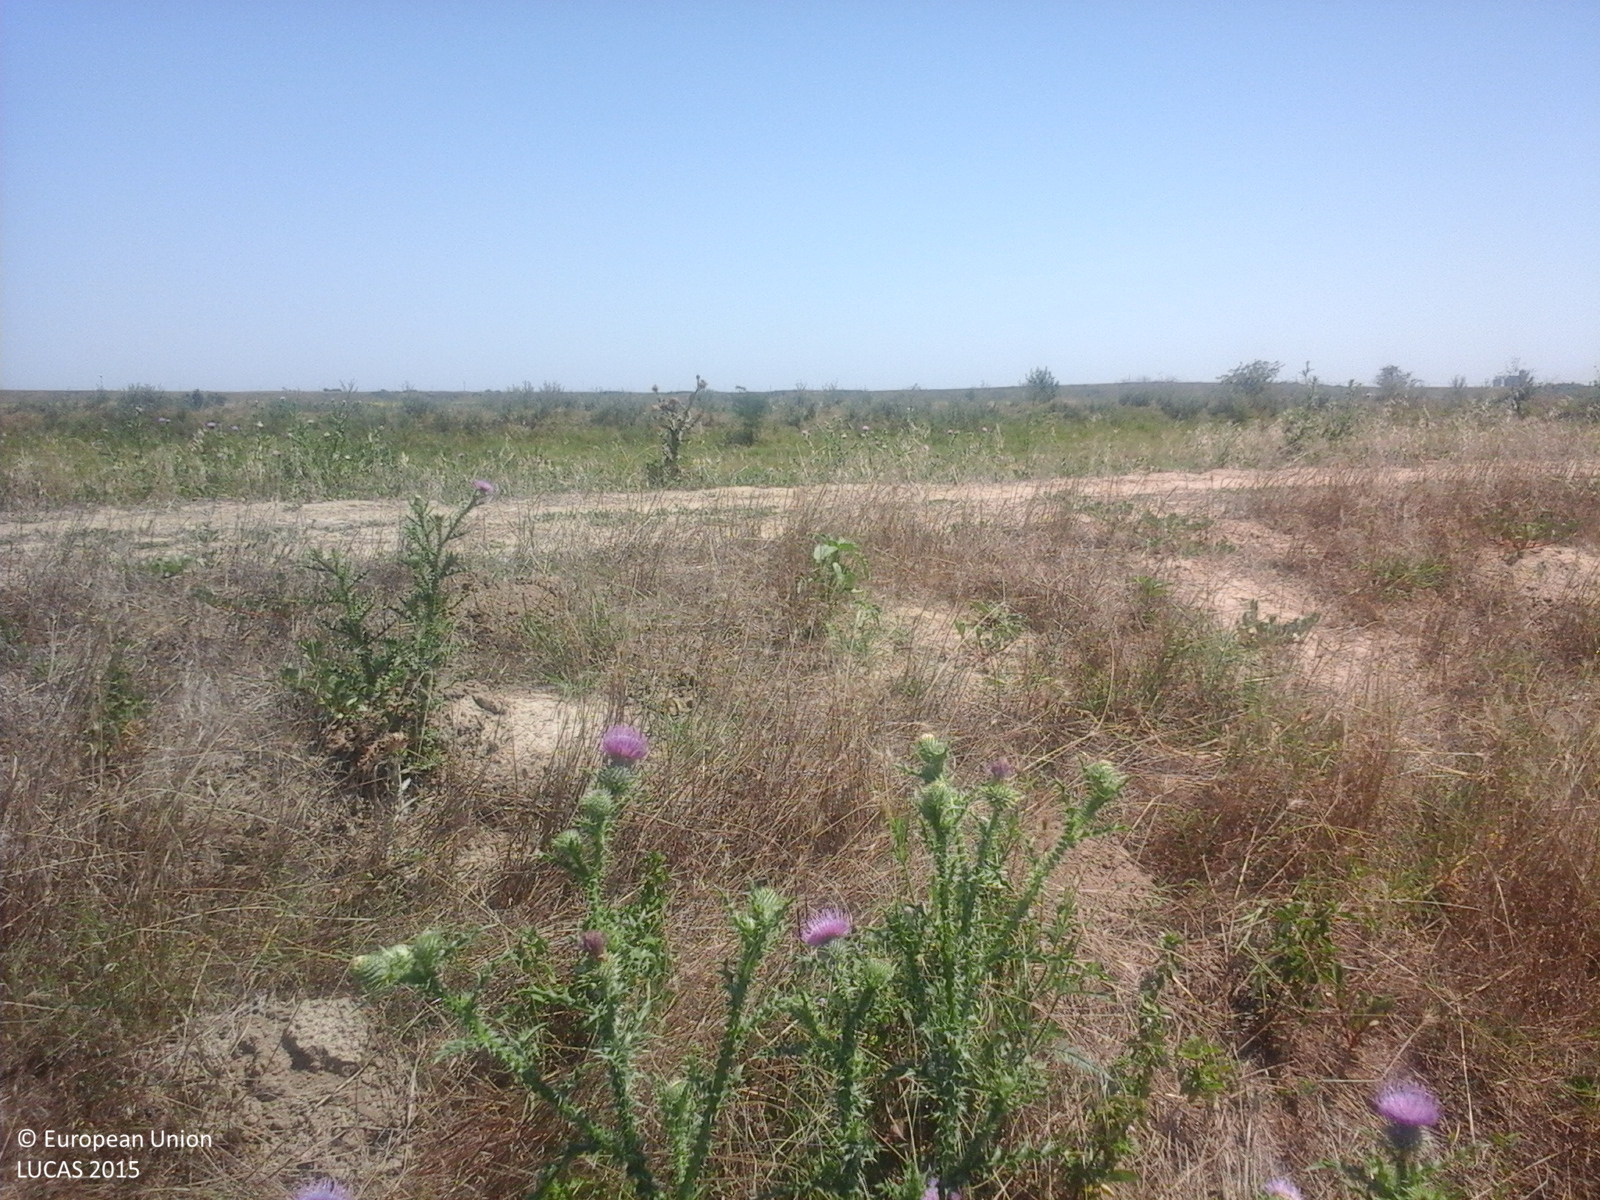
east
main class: Grassland
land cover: Grassland with sparse tree/shrub cover
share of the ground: > 75 %
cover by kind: herbaceous plants 85 %, shrubs 10 %, broadleaved forest trees 5 %
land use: Agriculture (excluding fallow land and kitchen gardens)
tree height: > 5 m
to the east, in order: Grassland with sparse tree/shrub cover; Tracks; Spontaneously vegetated surfaces; Inland fresh running water; Spontaneously vegetated surfaces; Tracks; Common wheat; Arable land (only in case pi)
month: July
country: RO
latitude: 44.2608
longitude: 26.4327
